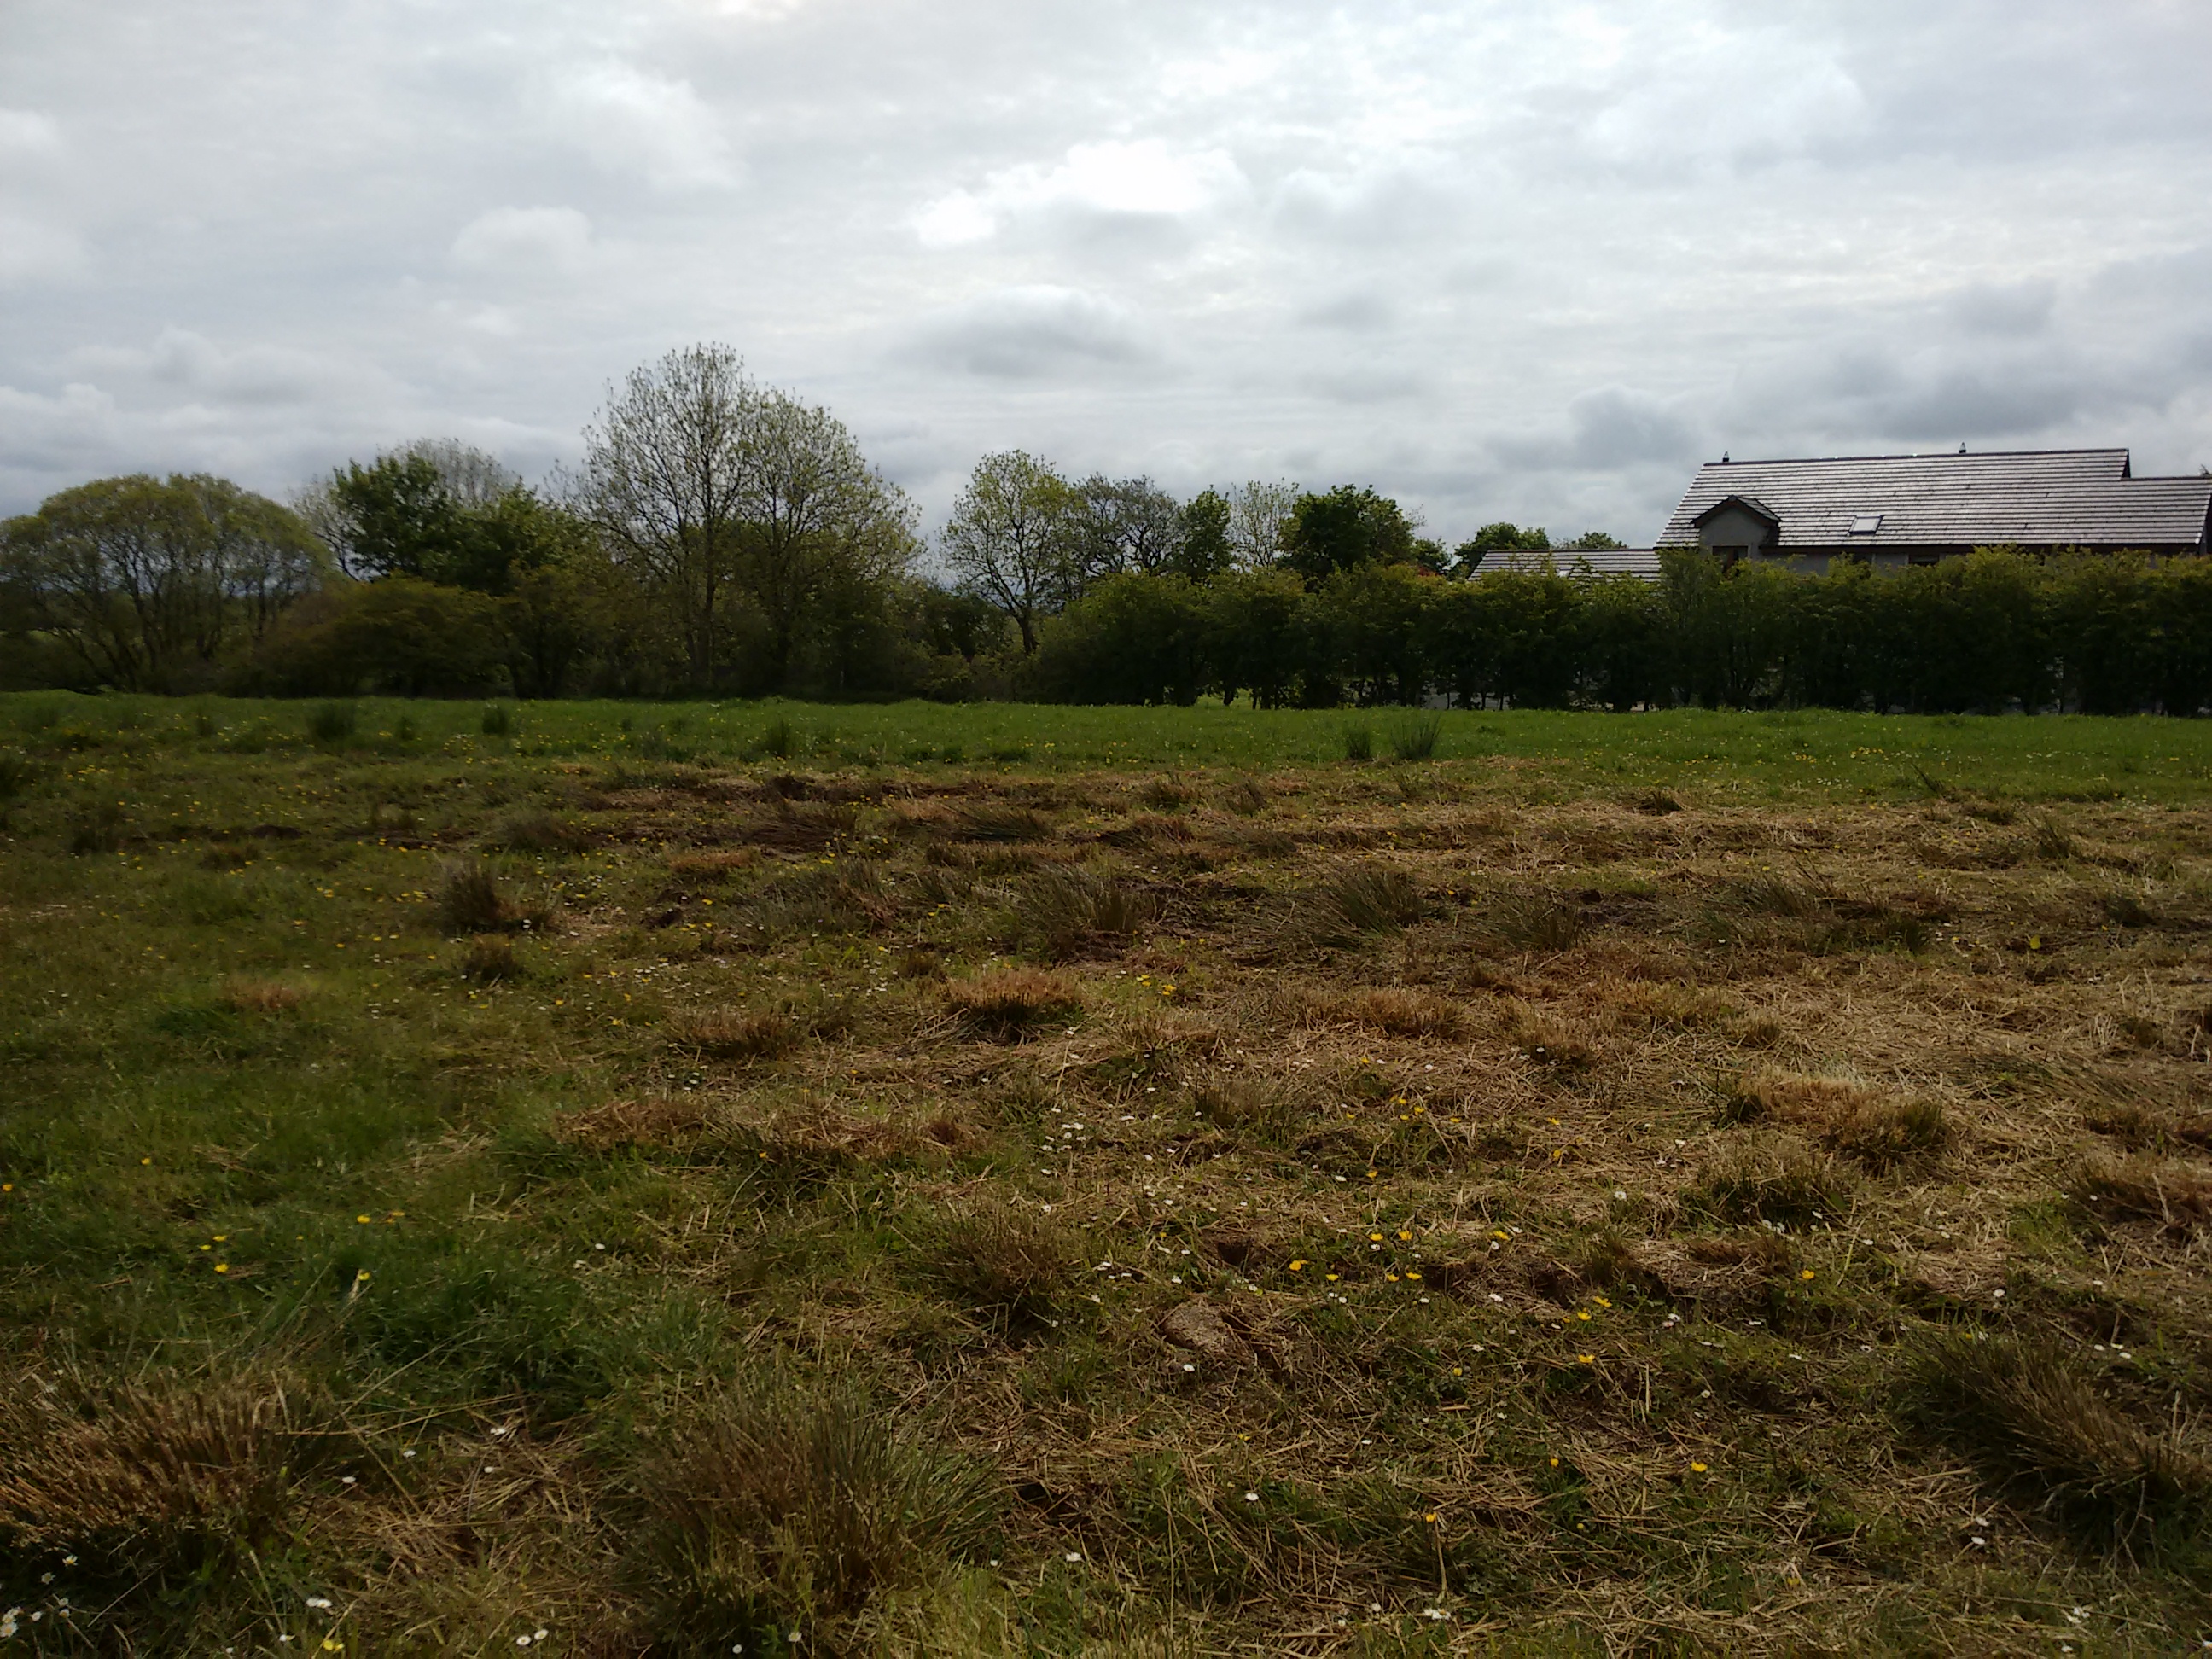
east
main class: Grassland
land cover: Grassland without tree/shrub cover
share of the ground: > 75 %
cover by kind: herbaceous plants 100 %
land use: Agriculture (excluding fallow land and kitchen gardens)
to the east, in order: Grassland without tree/shrub cover; Fences; Managed hedges; Artificial constructions in urban areas; Managed hedges; Grassland without tree/shrub cover; Fences; Rivers and streams; Fences; Shrubland with sparse tree cover
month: June
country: GB
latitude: 55.0360
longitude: -6.7632
